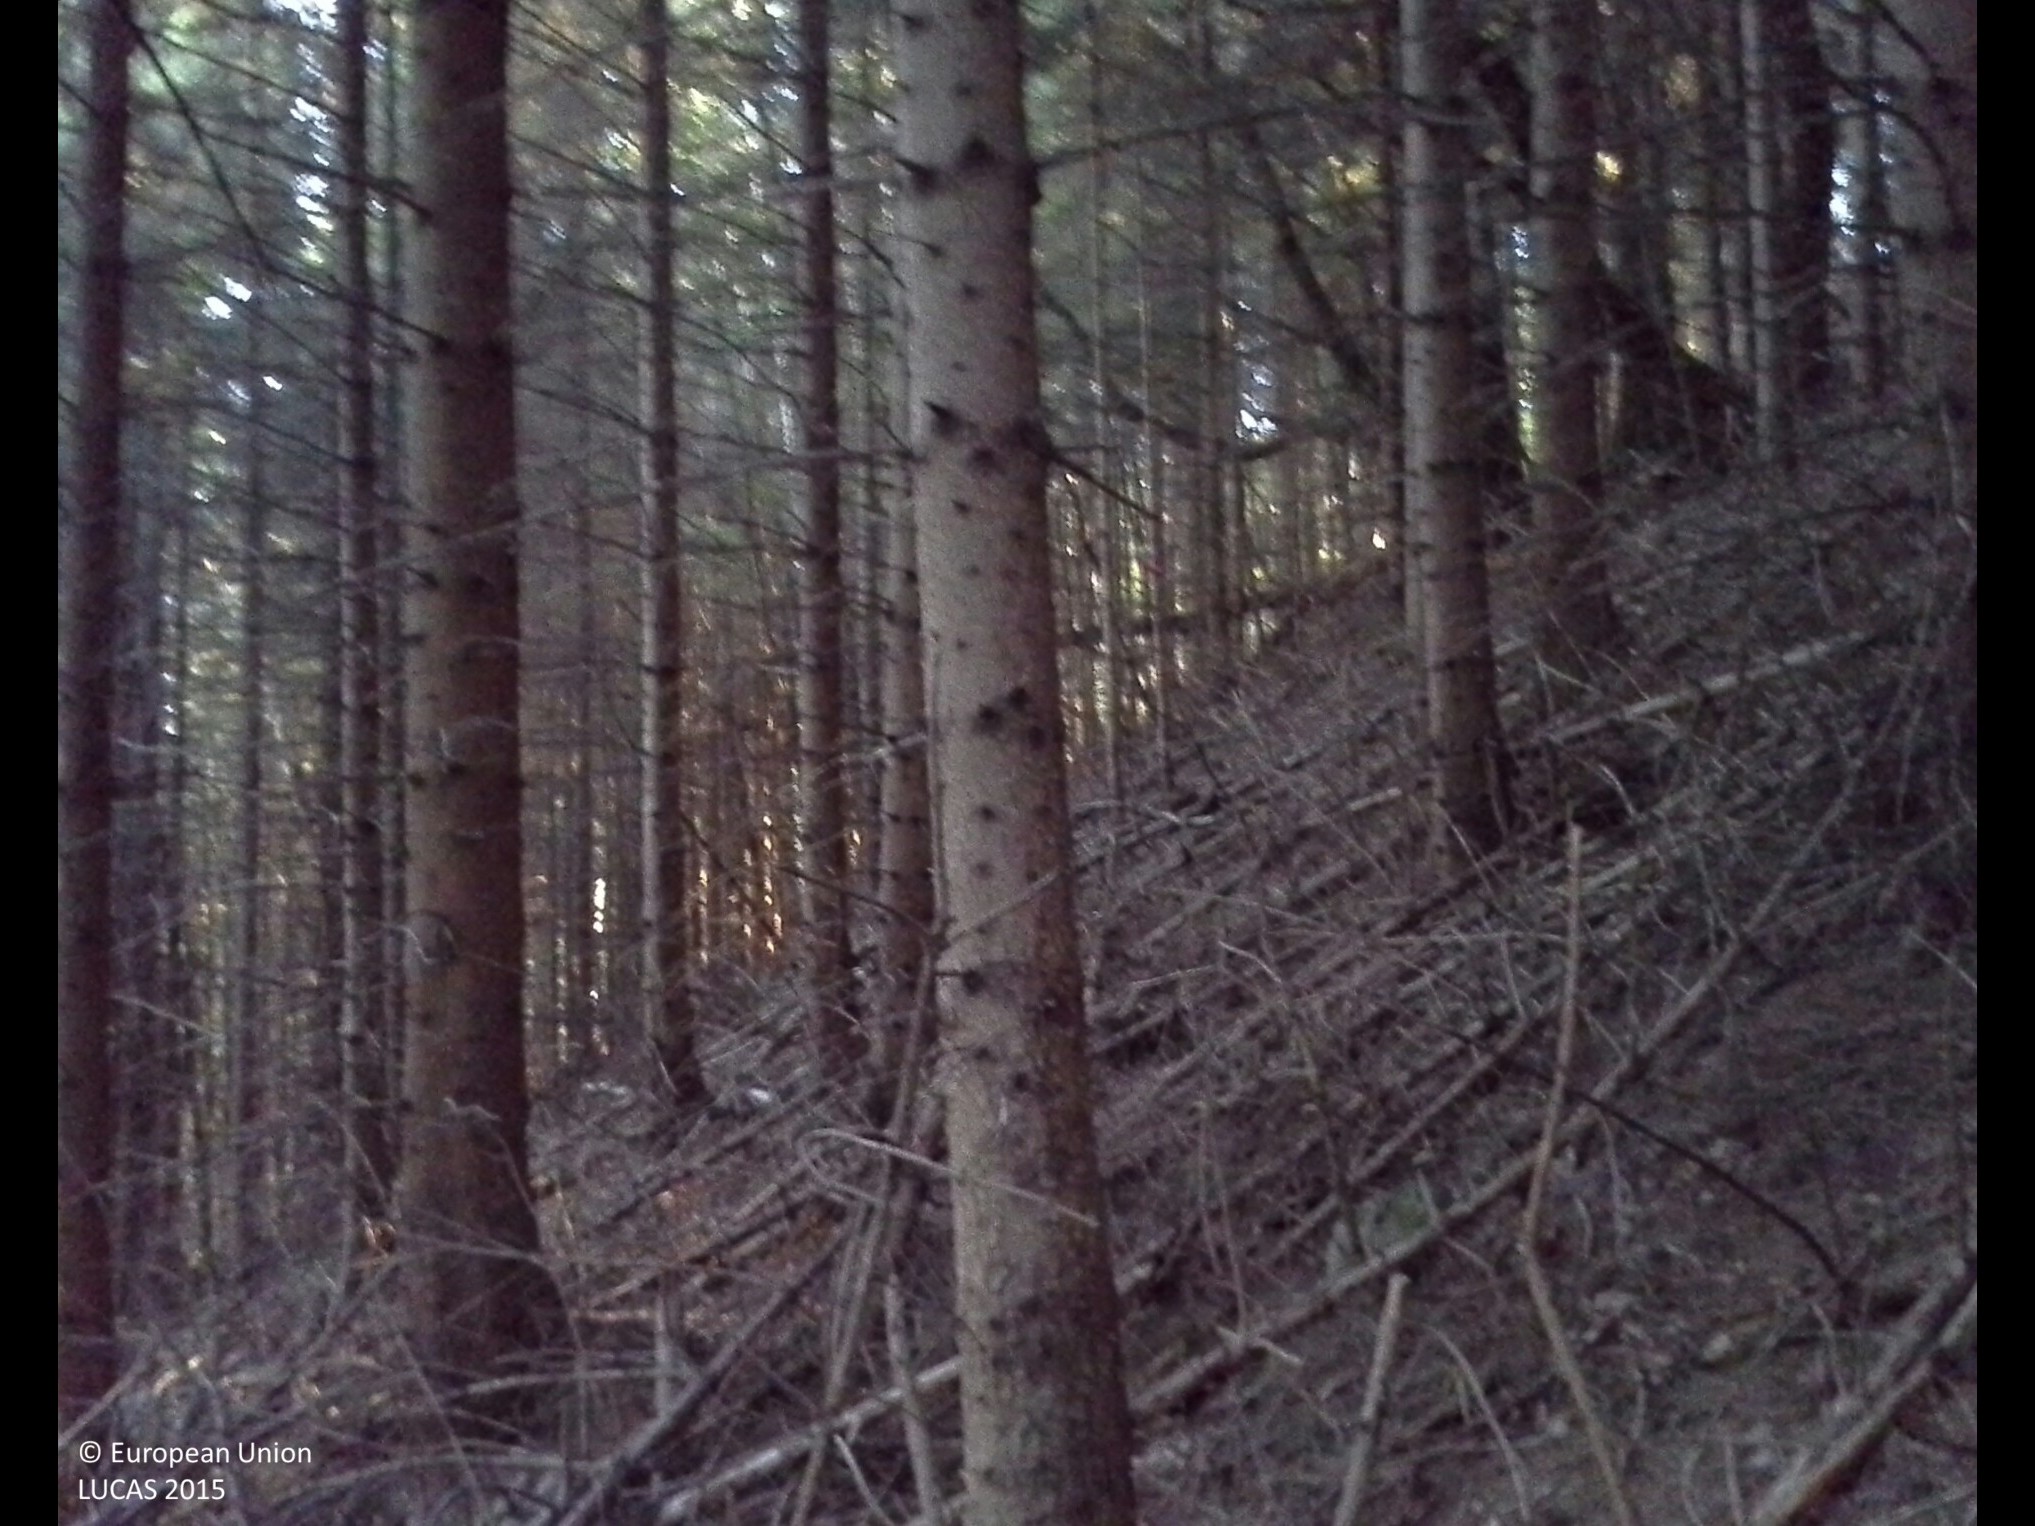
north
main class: Woodland
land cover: Spruce dominated coniferous woodland
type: alpine coniferous forest
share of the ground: > 75 %
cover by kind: coniferous forest trees 100 %
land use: Forestry
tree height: > 5 m
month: July
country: AT
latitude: 47.9308
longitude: 14.5642
